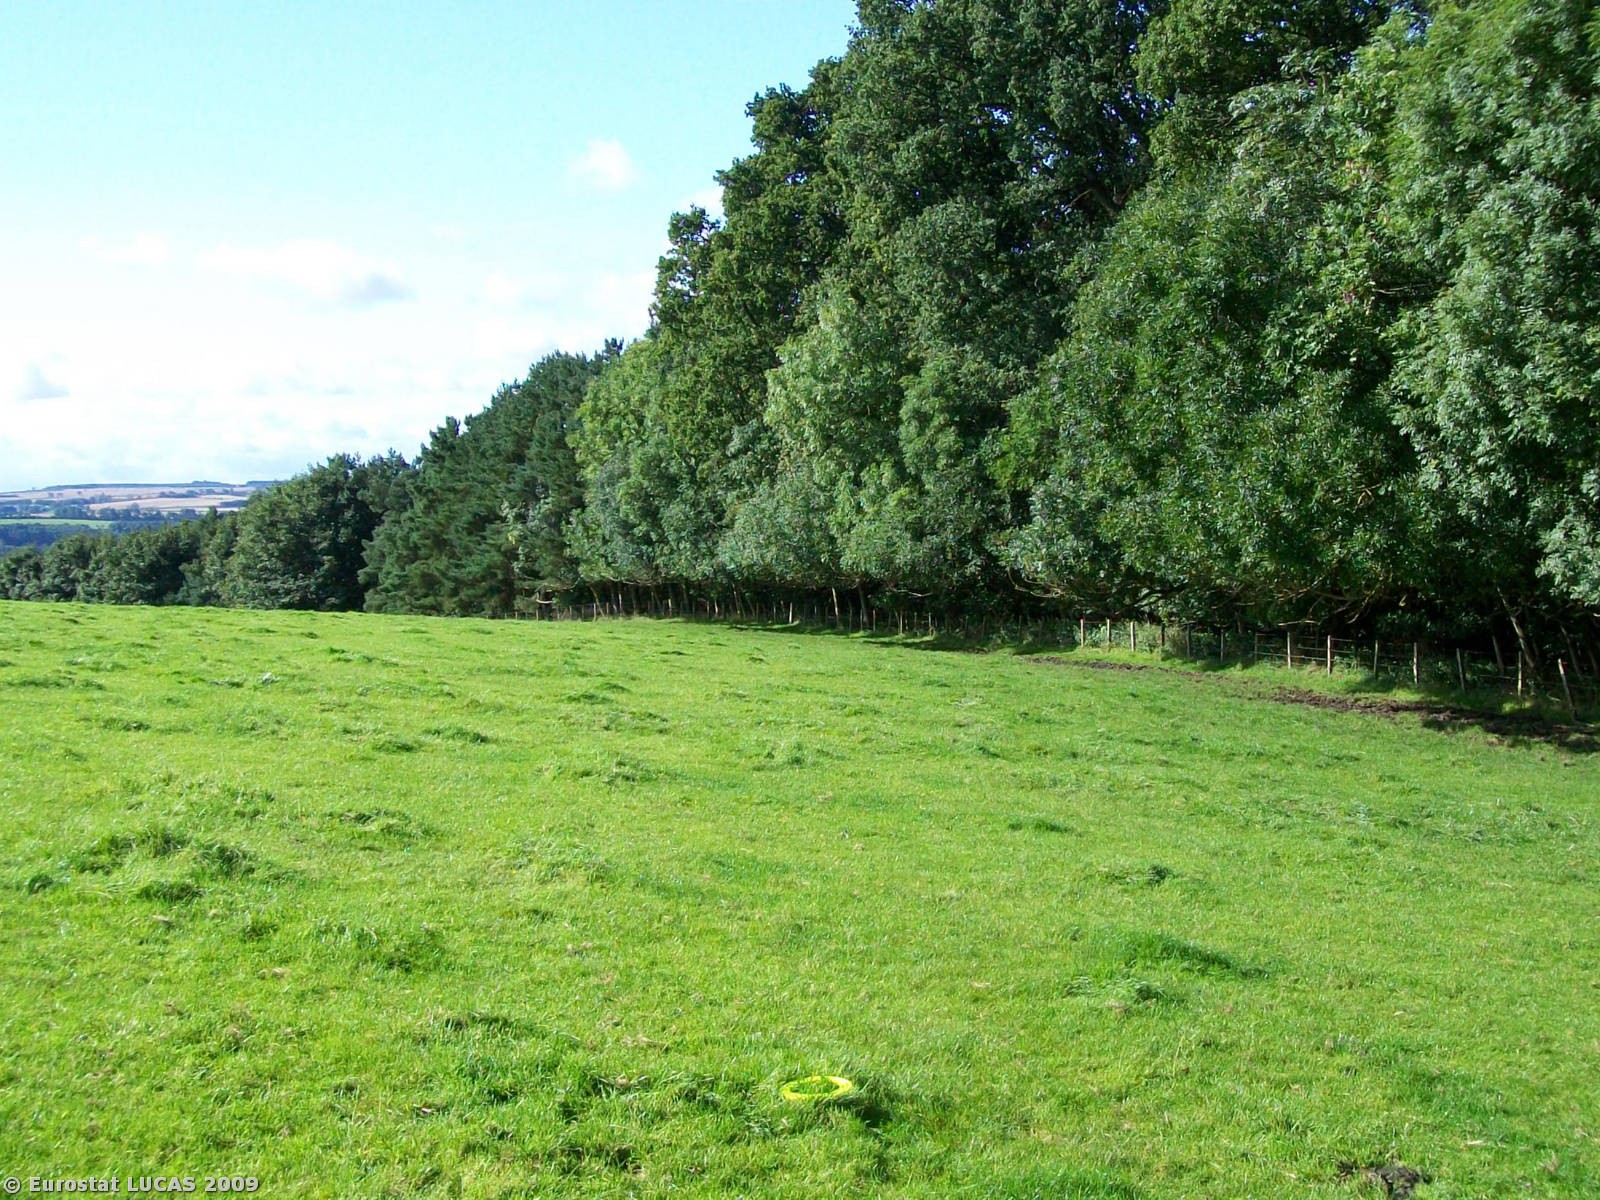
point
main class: Grassland
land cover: Grassland without tree/shrub cover
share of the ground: > 75 %
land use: Agriculture (excluding fallow land and kitchen gardens)
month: September
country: GB
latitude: 55.6677
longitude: -2.2828
